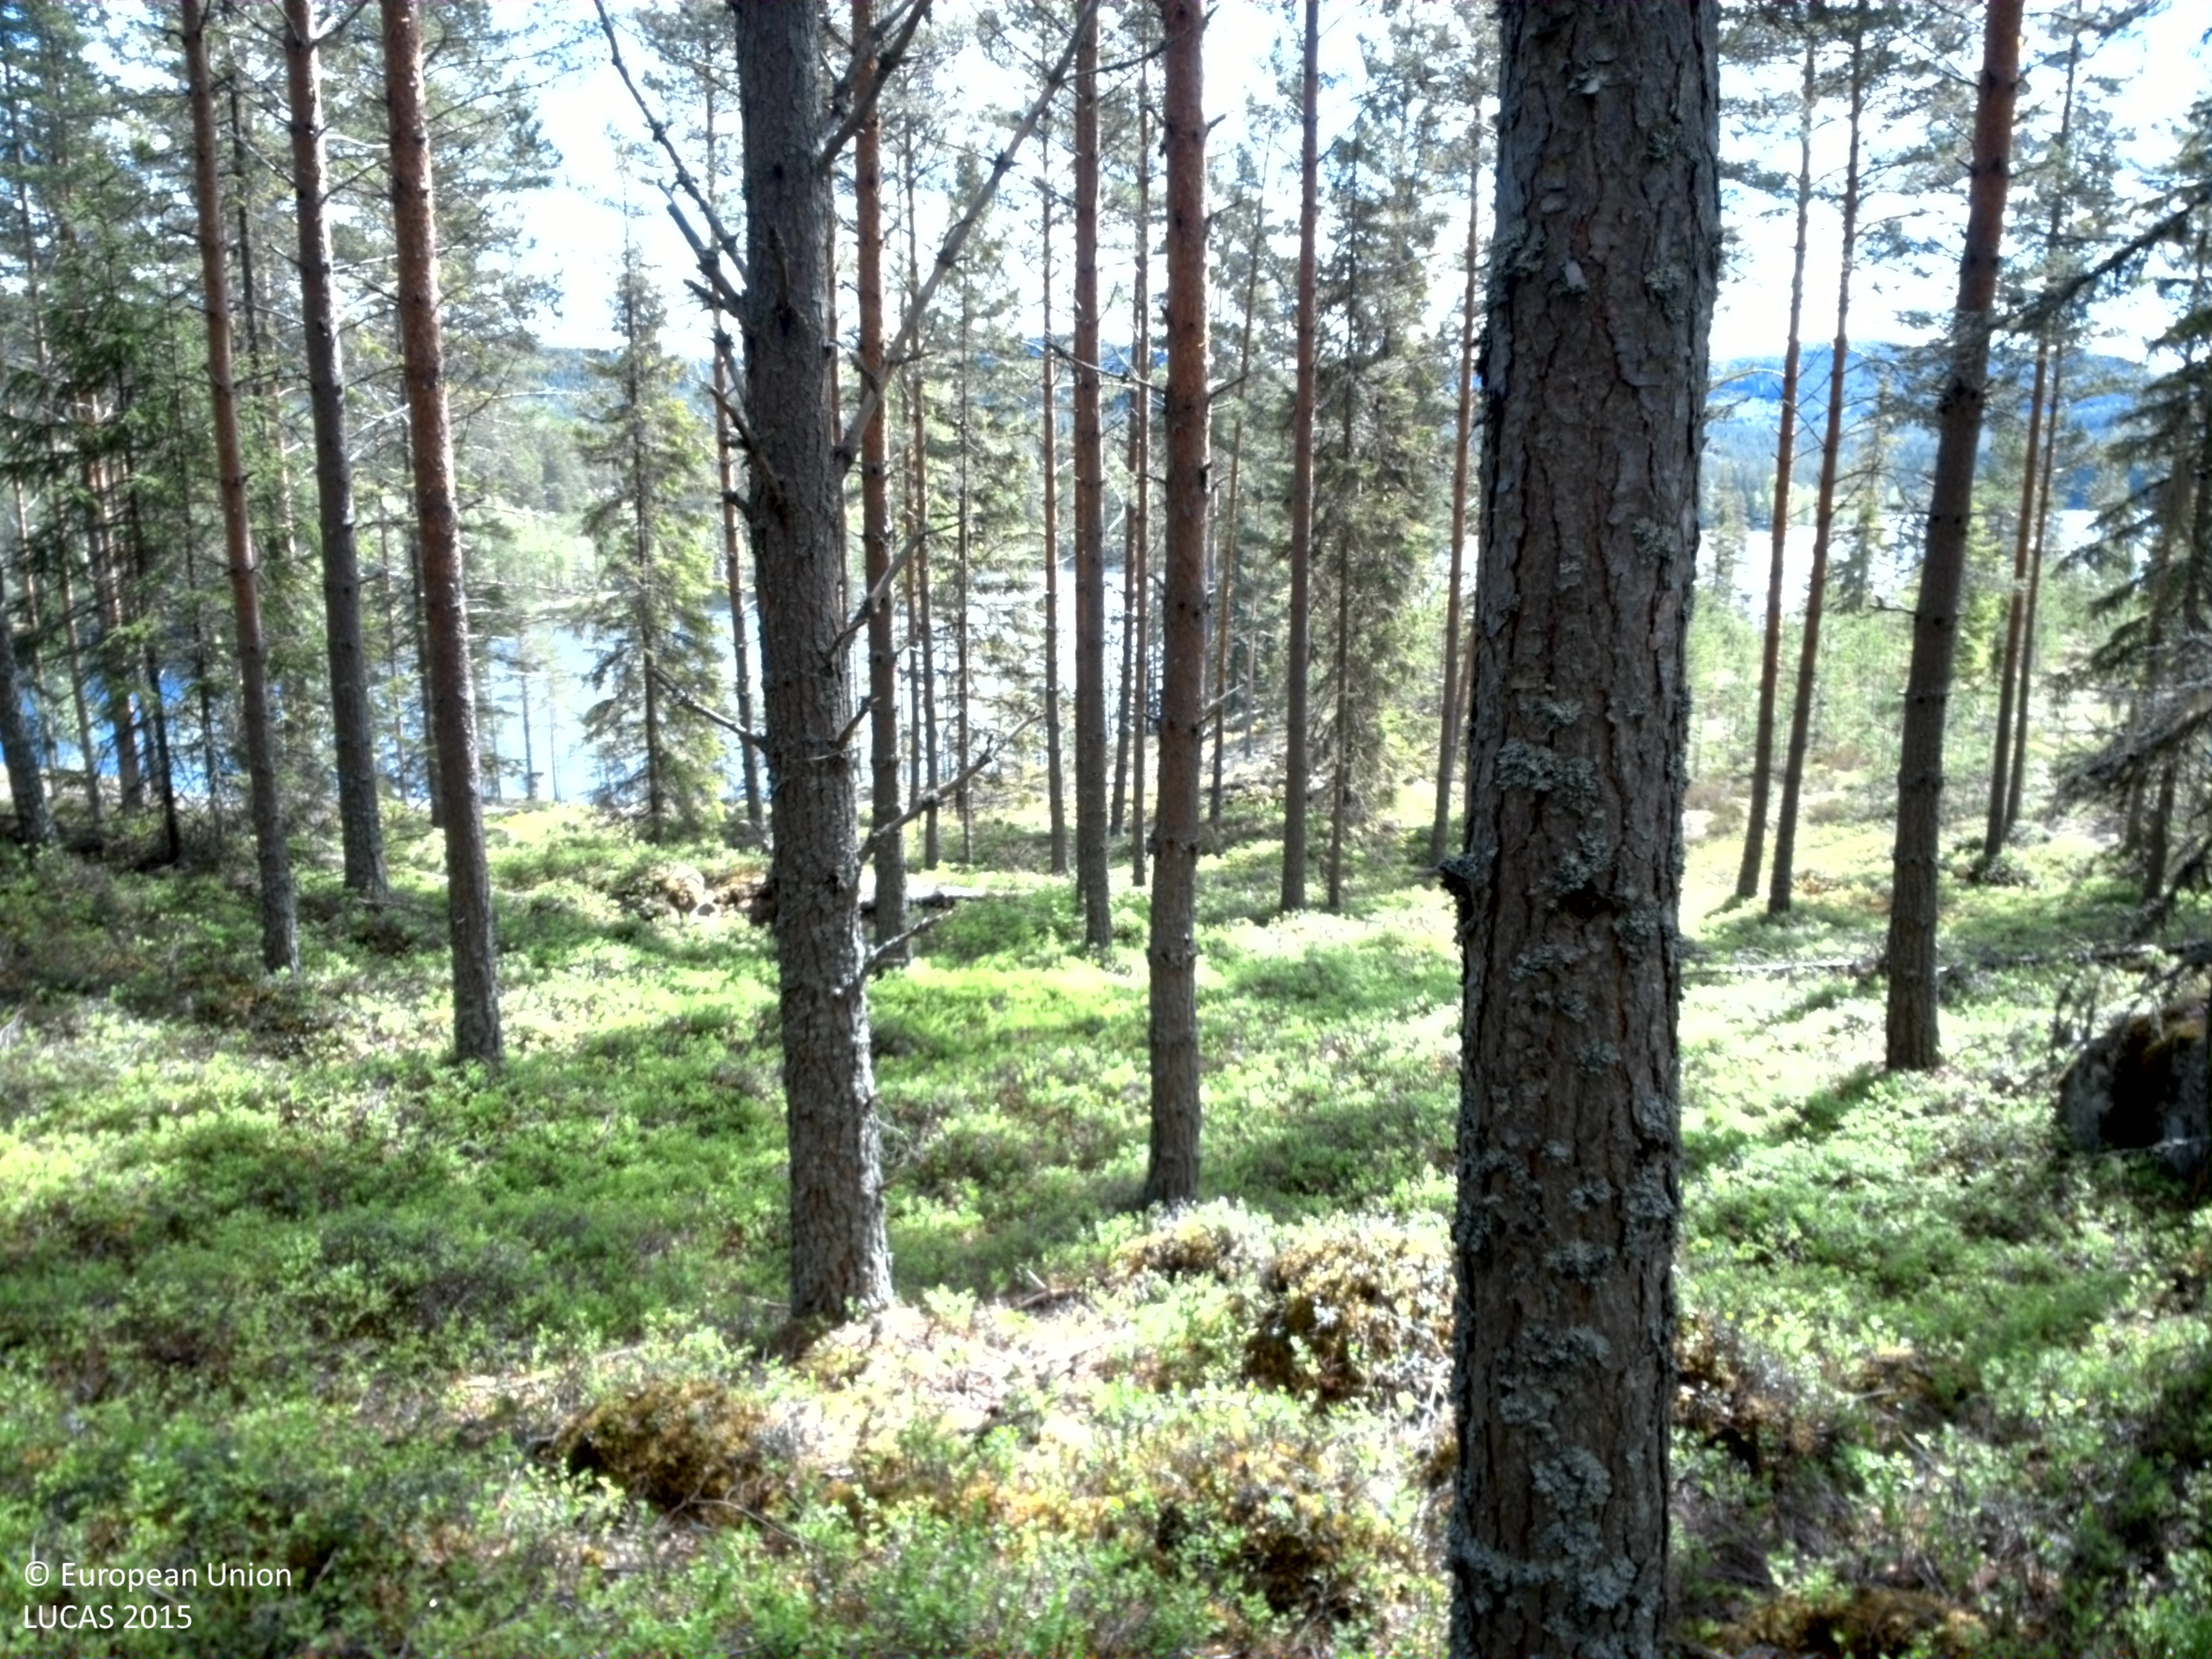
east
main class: Woodland
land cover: Pine dominated coniferous woodland
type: boreal forest
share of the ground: 50 - 75 %
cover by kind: coniferous forest trees 50 %, shrubs 50 %
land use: Forestry
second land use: Amenities, museums, leisure
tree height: > 5 m
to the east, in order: Pine dominated coniferous woodland; Shrubland without tree cover; Pine dominated mixed woodland; Inland fresh water bodies
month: June
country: SE
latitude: 60.2910
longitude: 13.0843
